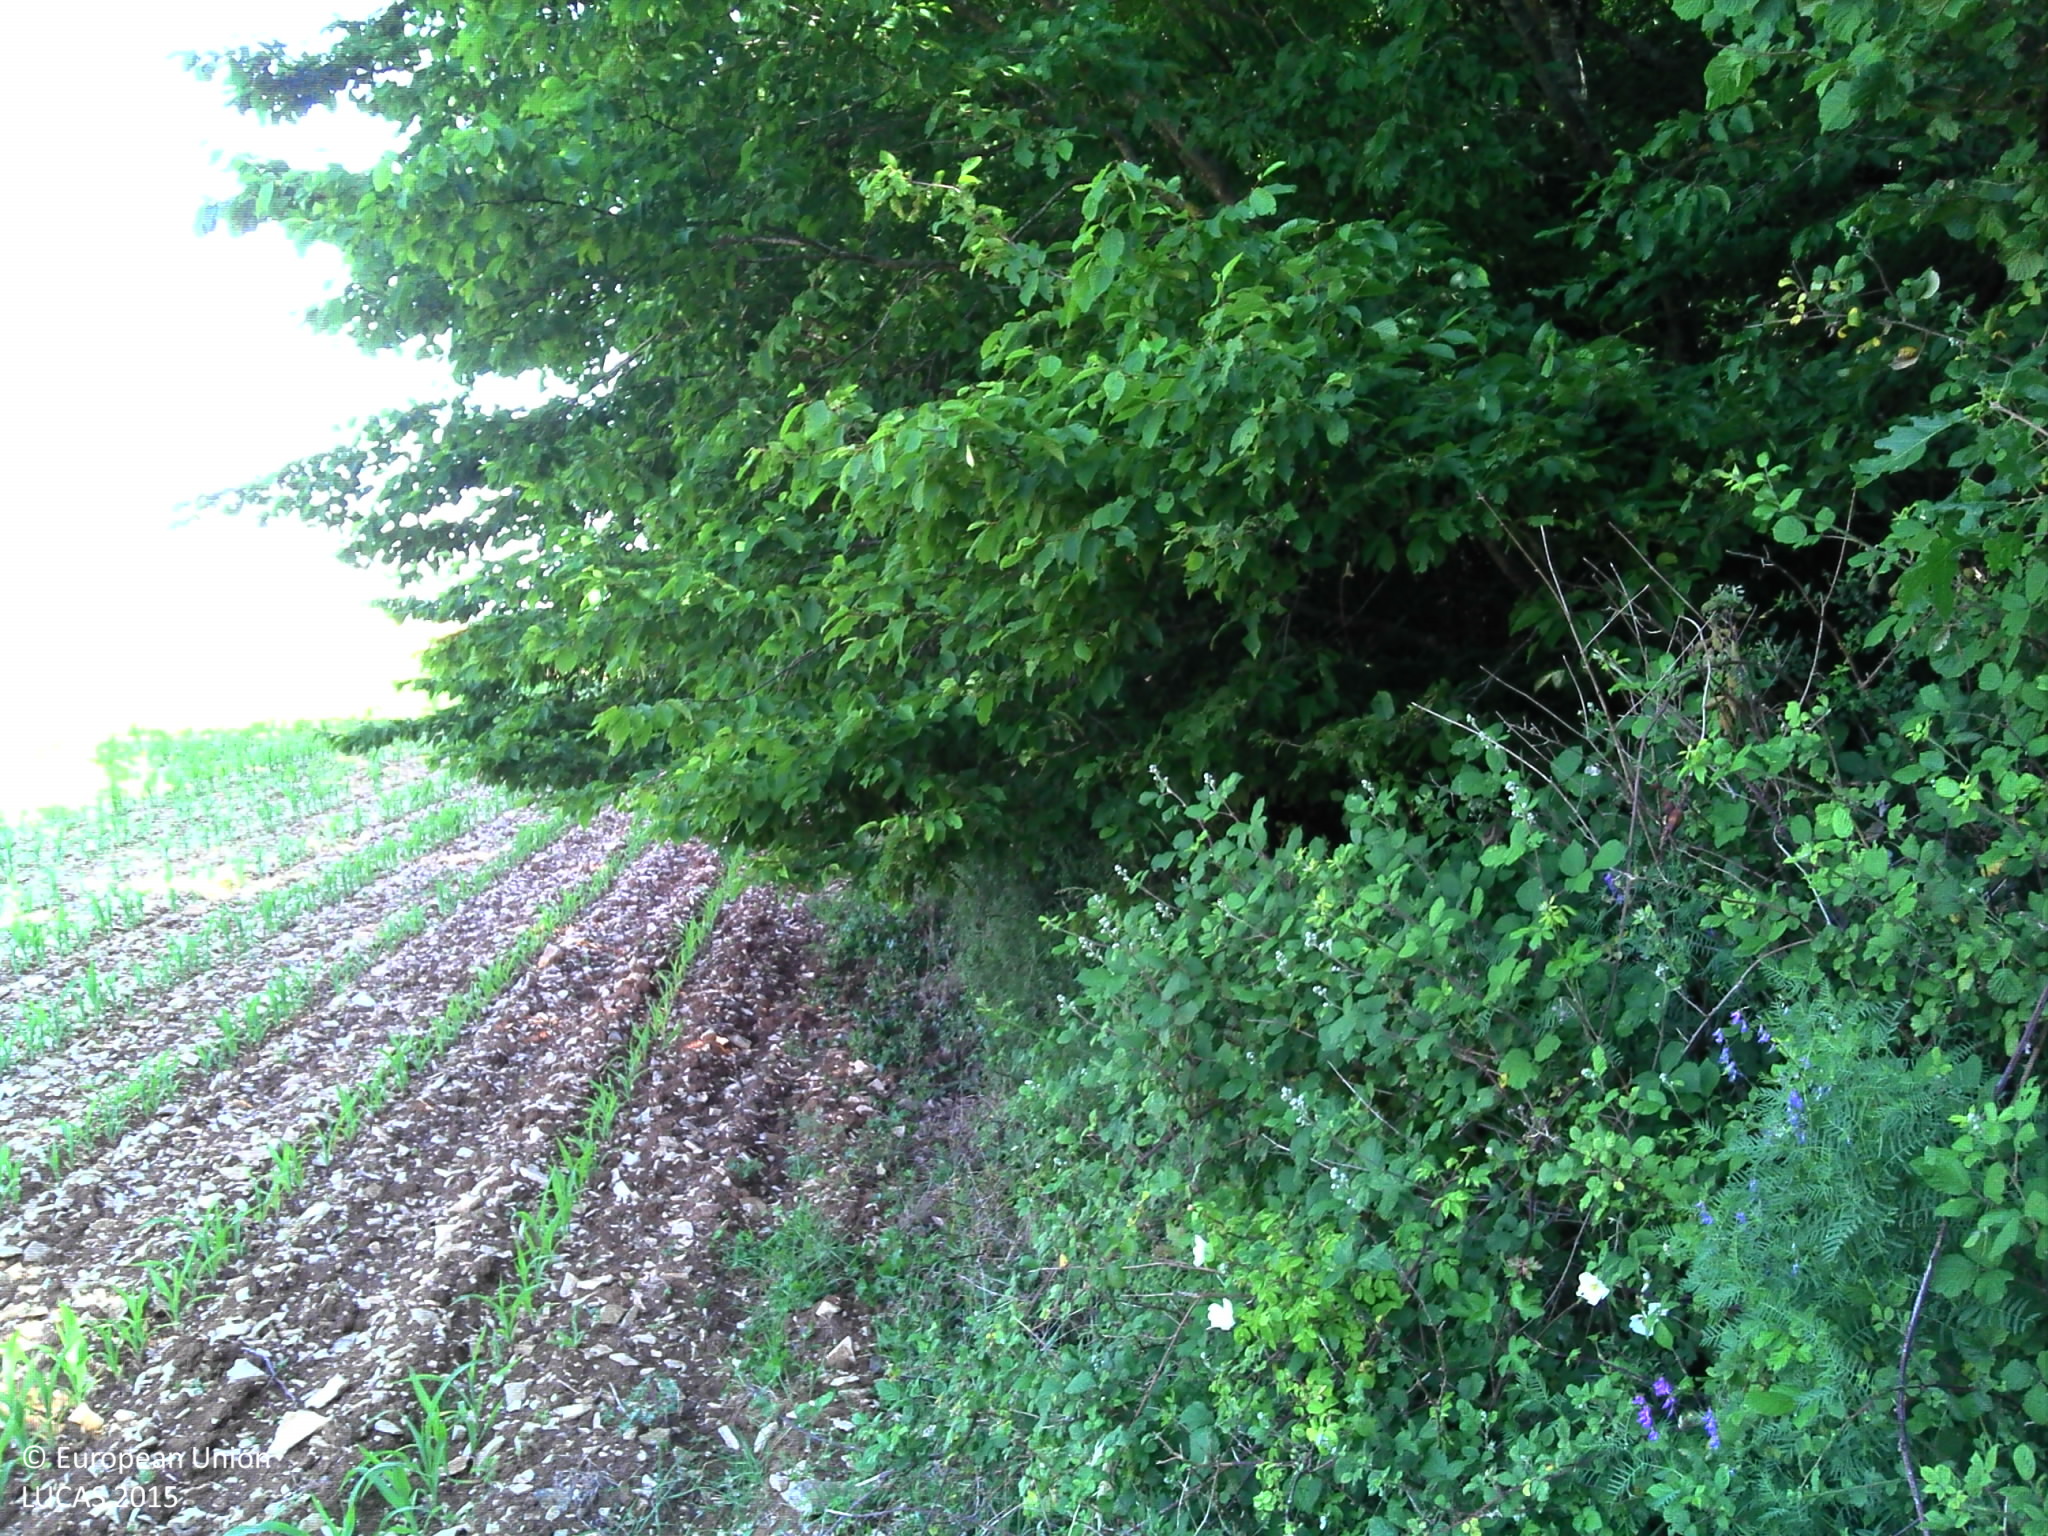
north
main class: Woodland
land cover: Broadleaved woodland
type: acidophilous oak and oak-birch forest
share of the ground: > 75 %
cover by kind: broadleaved forest trees 95 %, shrubs 5 %
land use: Forestry
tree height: > 5 m
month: June
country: FR
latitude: 47.0750
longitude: 2.6585
